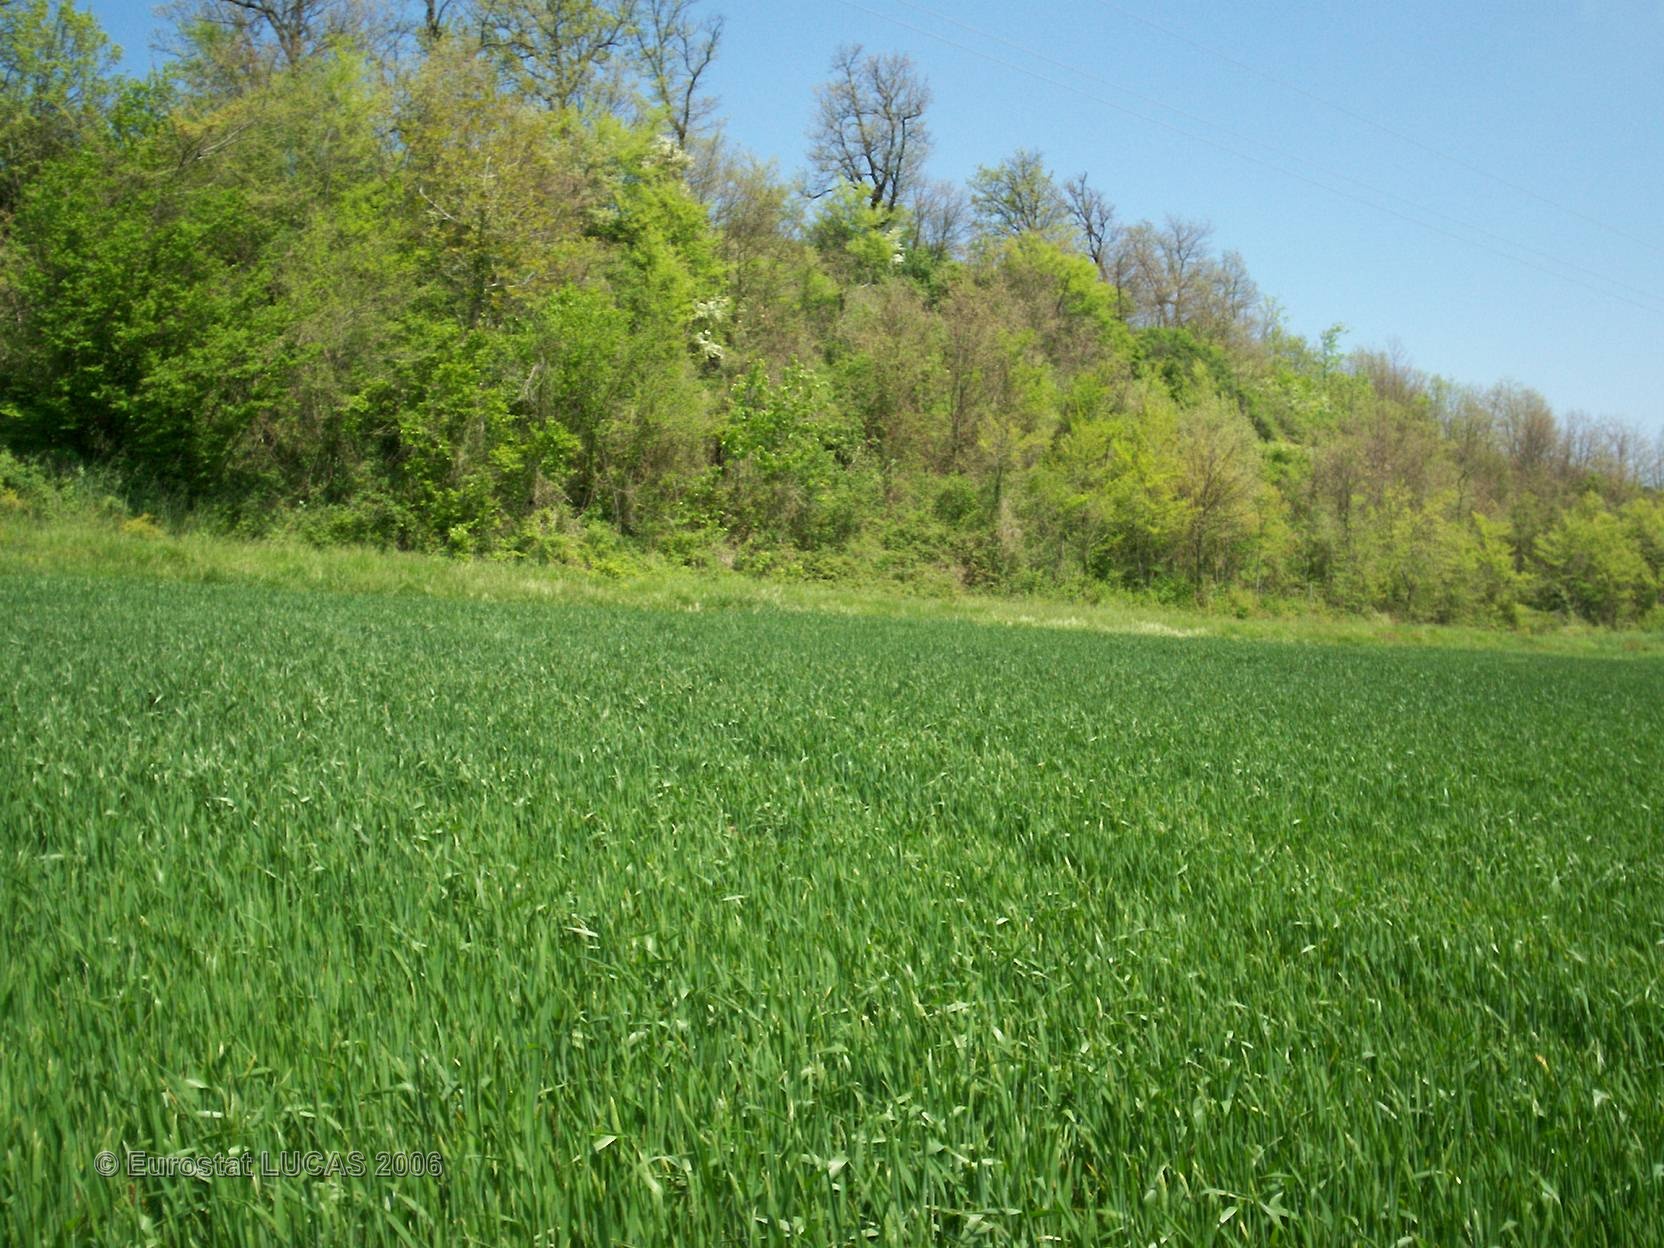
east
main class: Cropland
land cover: Durum wheat
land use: Agriculture (excluding fallow land and kitchen gardens)
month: April
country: FR
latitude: 43.7151
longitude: 1.9988
